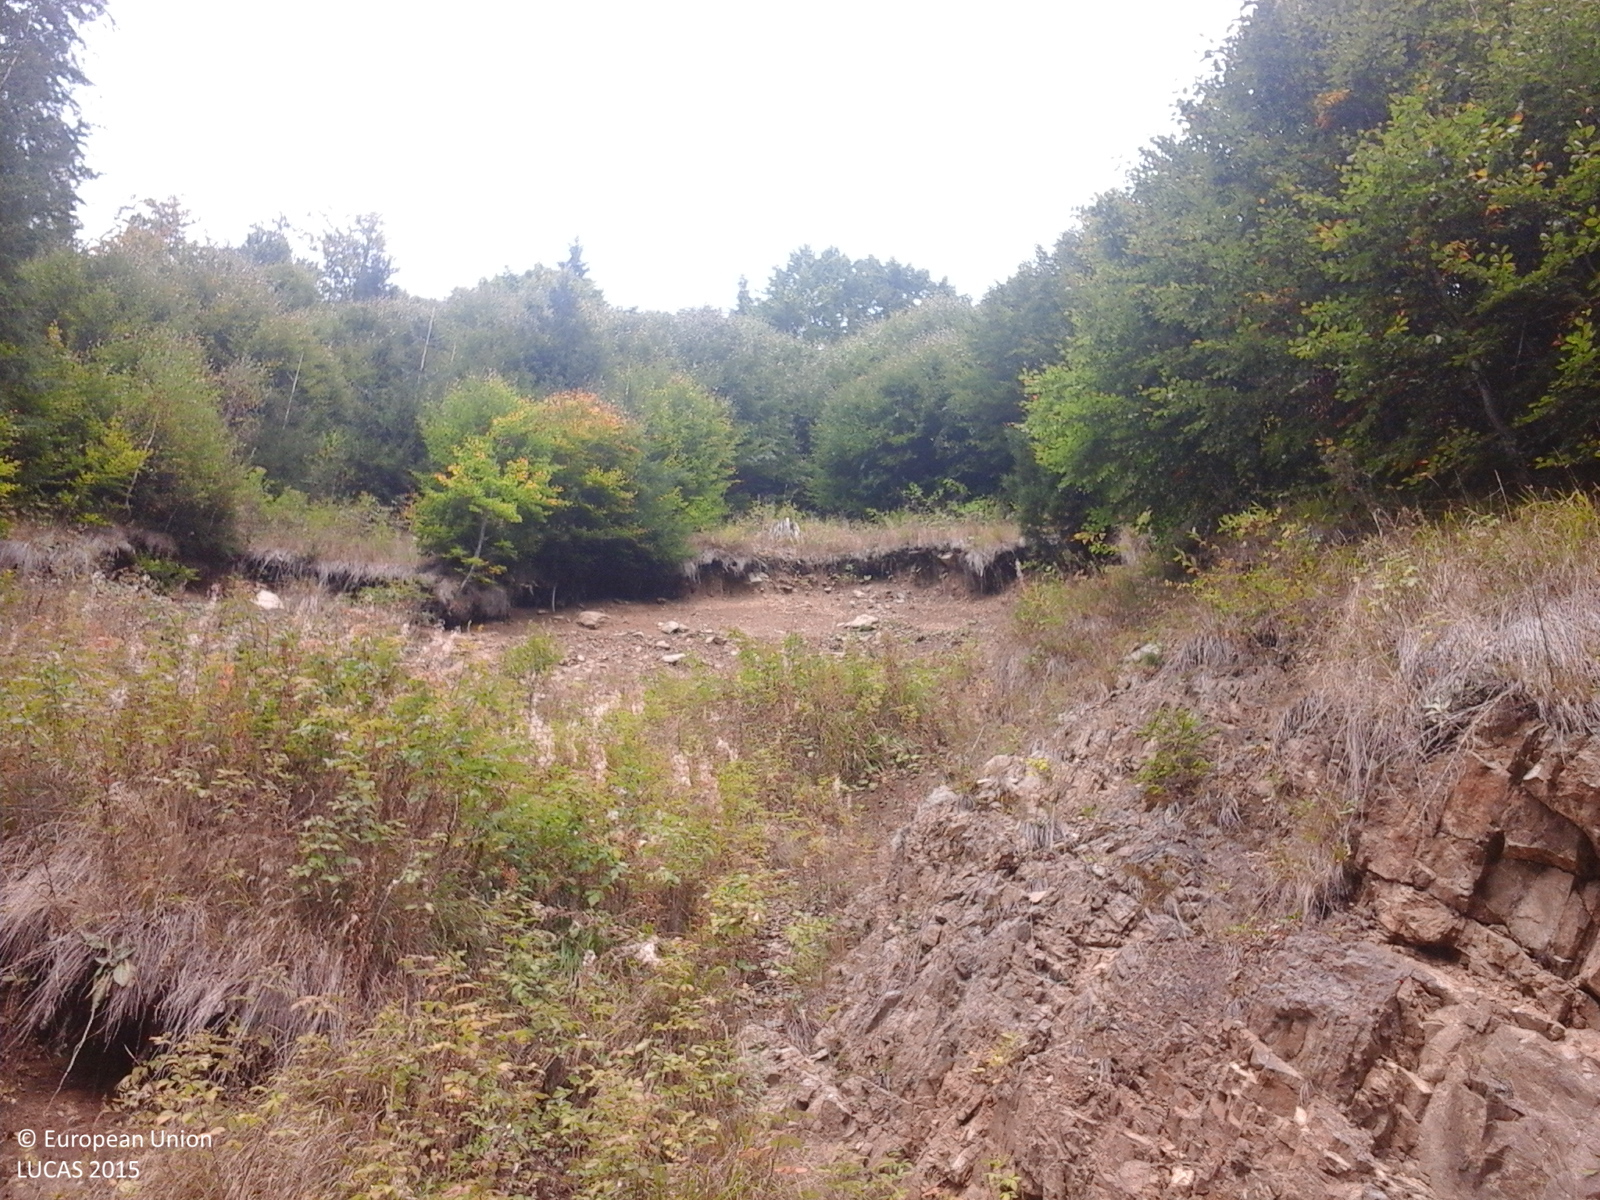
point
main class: Woodland
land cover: Spruce dominated mixed woodland
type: alpine coniferous forest
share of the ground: > 75 %
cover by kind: coniferous forest trees 65 %, broadleaved forest trees 35 %
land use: Forestry
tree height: > 5 m
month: September
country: RO
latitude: 45.4123
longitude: 23.5417
